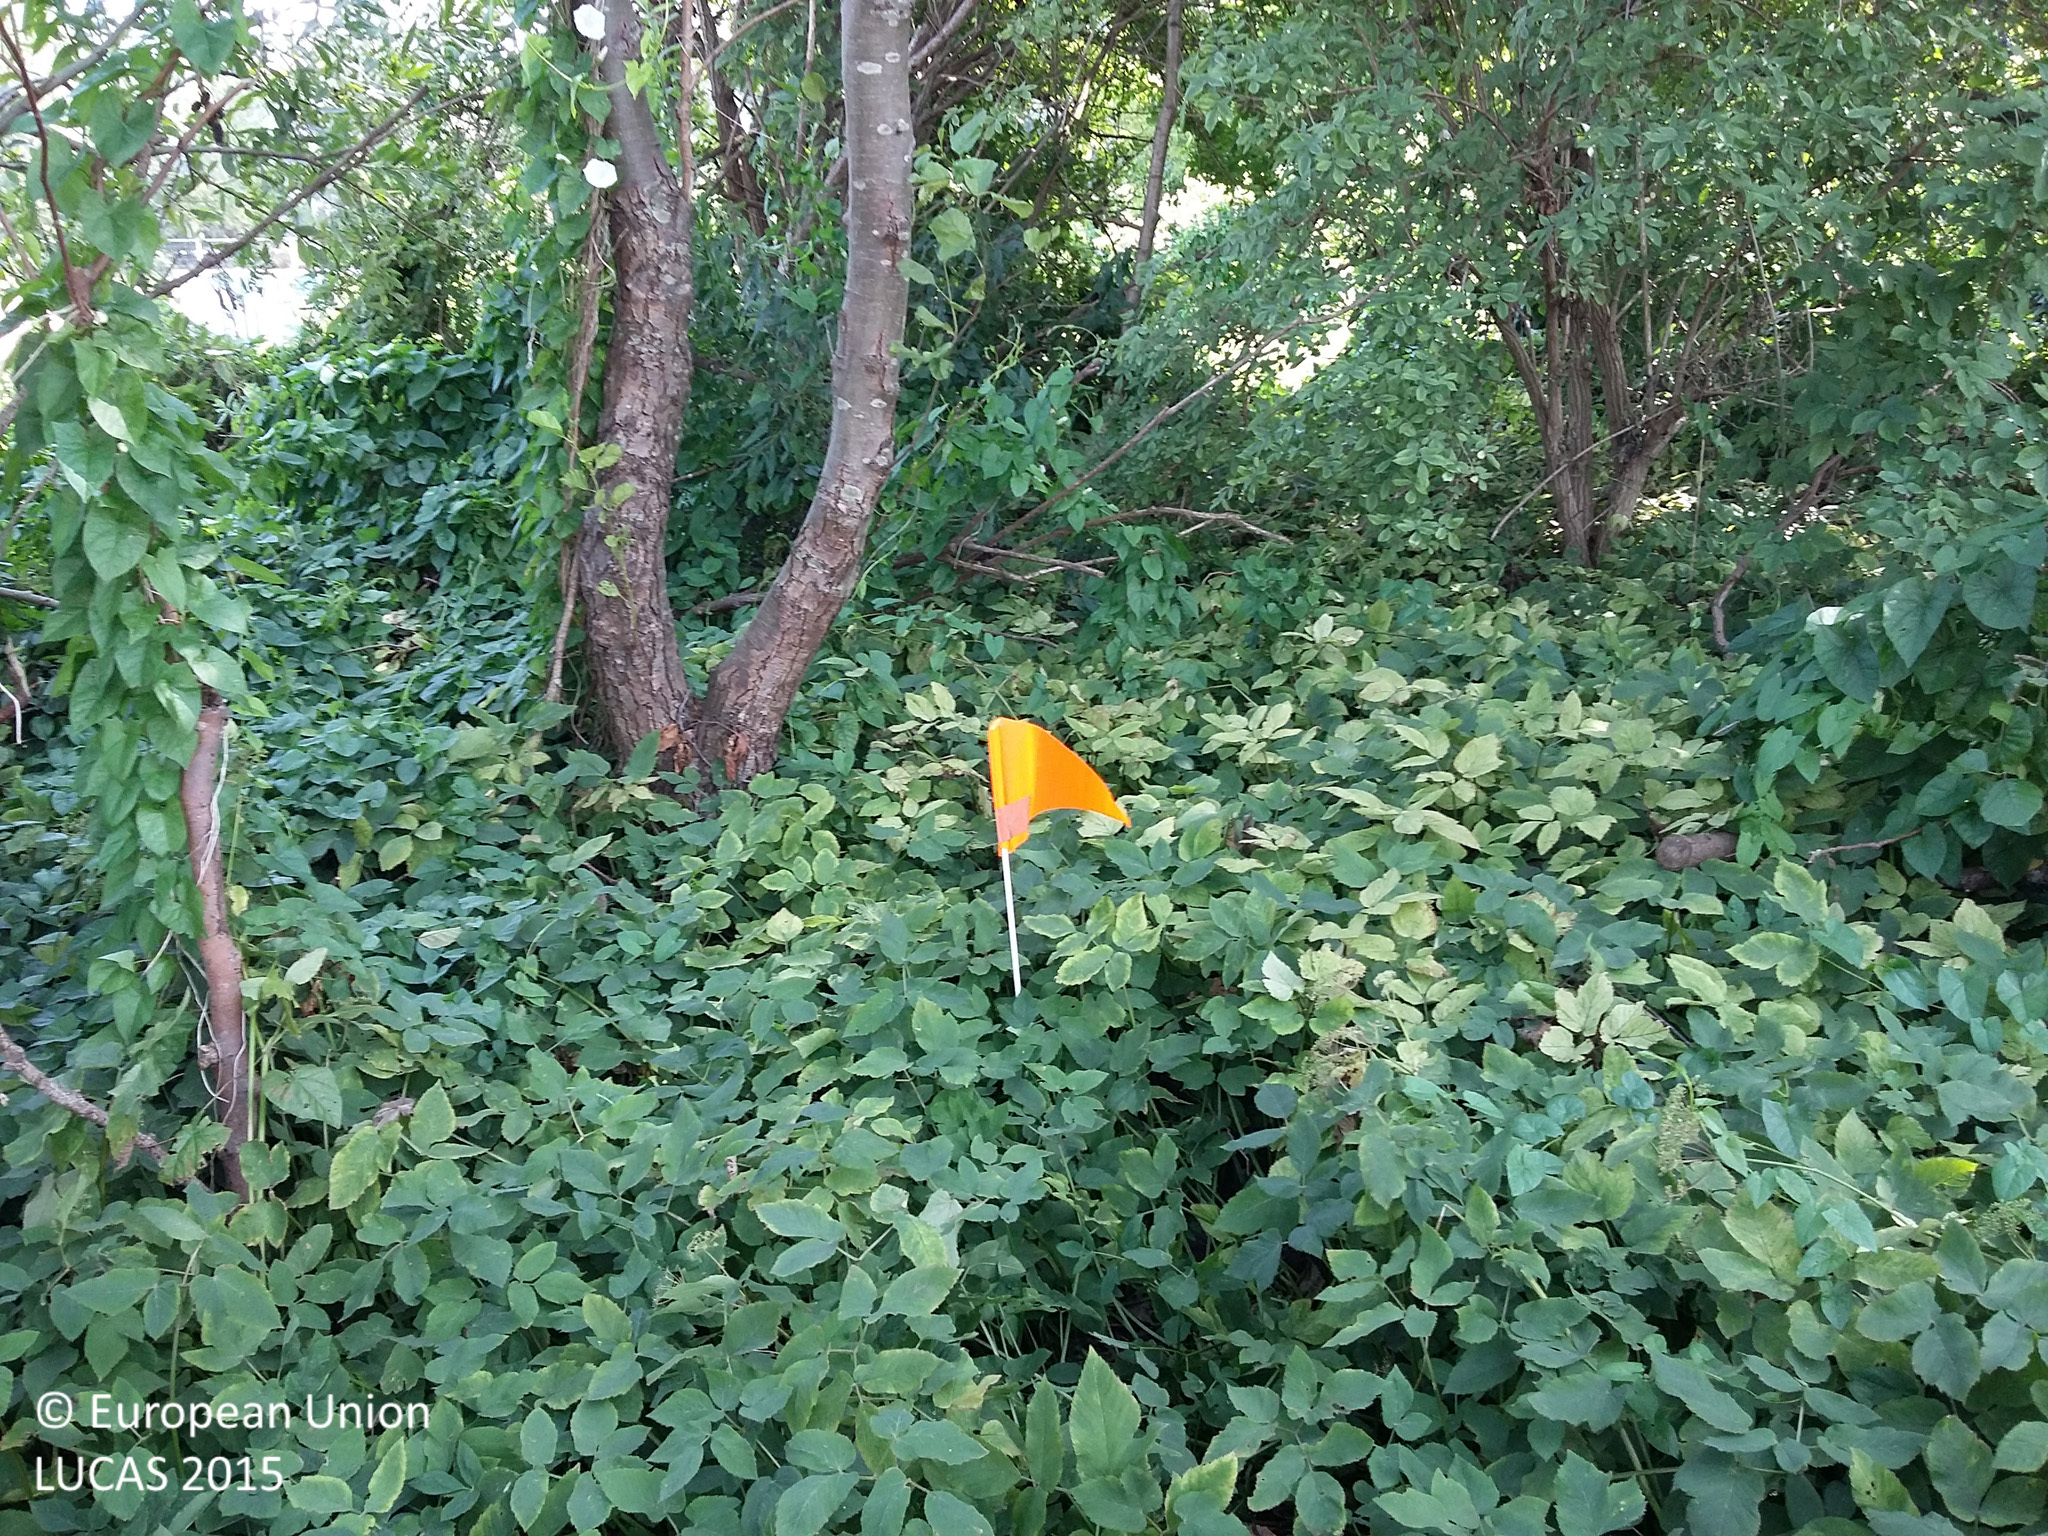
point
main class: Woodland
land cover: Broadleaved woodland
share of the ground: > 75 %
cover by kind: broadleaved forest trees 60 %, herbaceous plants 40 %
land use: Semi-natural and natural areas not in use
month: August
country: DK
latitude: 55.4862
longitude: 12.1663
